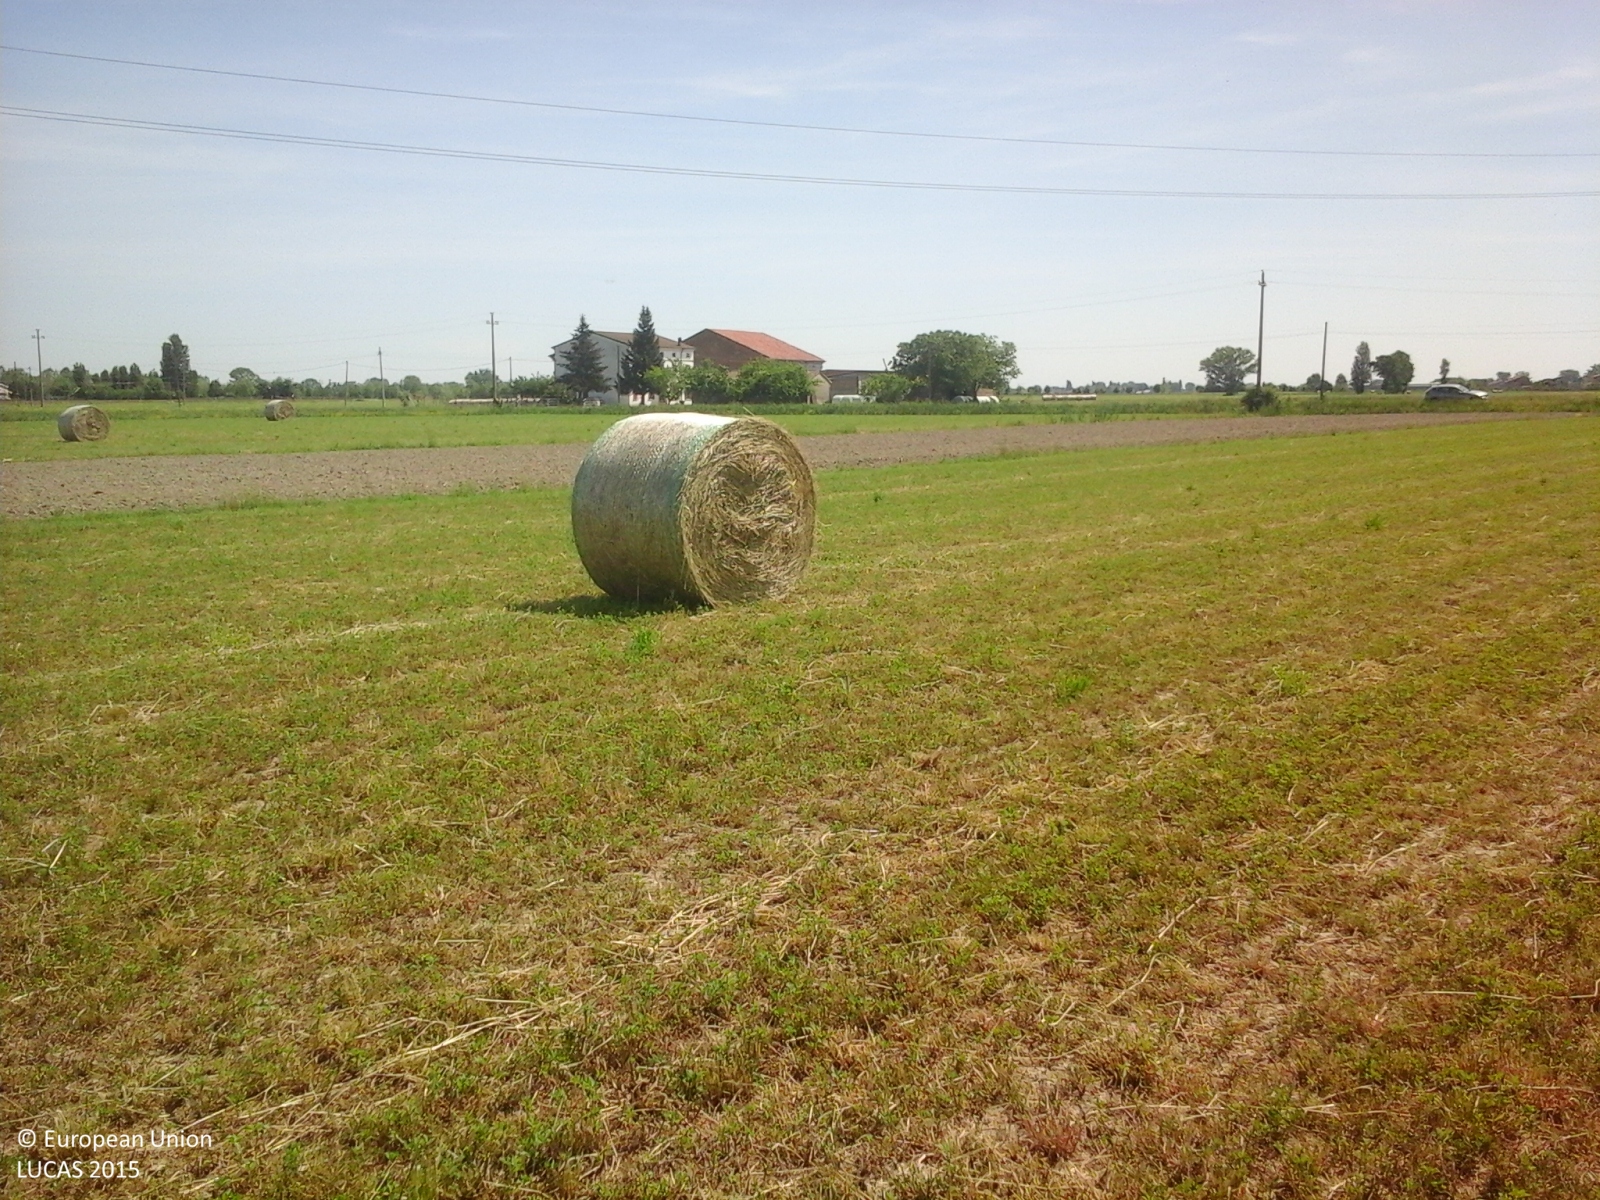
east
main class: Cropland
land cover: Lucerne
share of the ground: > 75 %
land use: Agriculture (excluding fallow land and kitchen gardens)
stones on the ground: < 10 %
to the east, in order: Lucerne; Electric lines; Ditches and canals; Lucerne; Electric lines; Ditches and canals; Electric lines; Grass margins; Paved roads, cycling and walking lanes; Grass margins; Ditches and canals; Lucerne; Grass margins; Tracks; Single bushes/trees; Grass margins; Artificial constructions in urban areas; Grassland without tree/shrub cover; Ditches and canals; Temporary grasslands
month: May
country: IT
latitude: 44.9780
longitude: 10.8733
